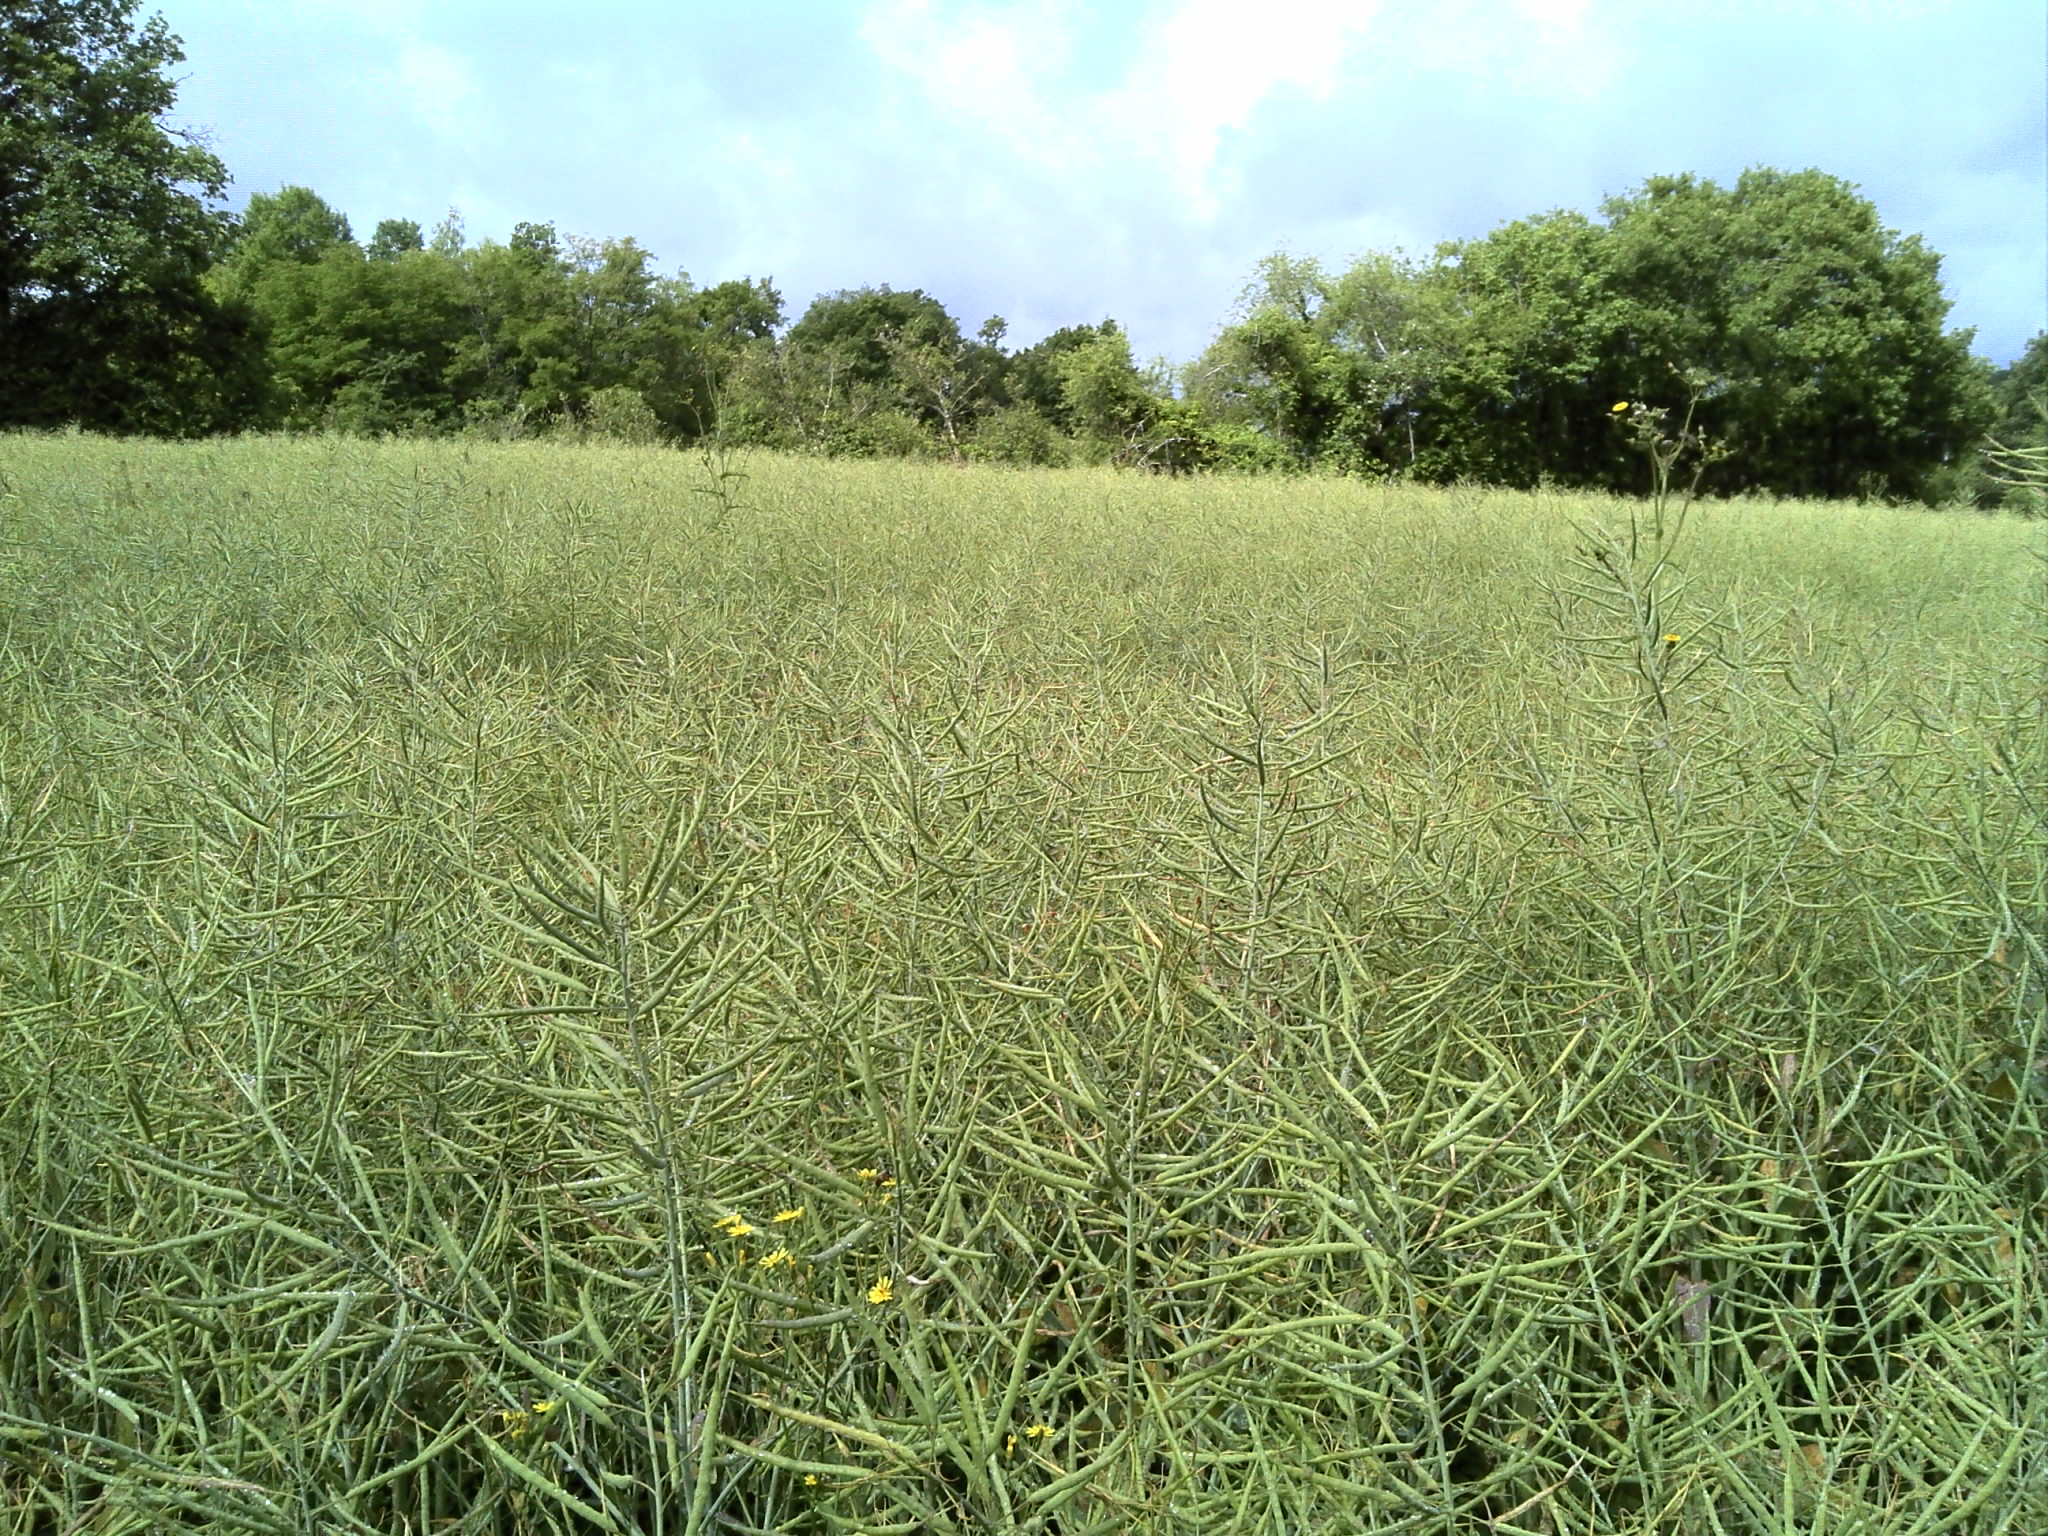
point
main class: Cropland
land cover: Rape and turnip rape
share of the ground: > 75 %
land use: Agriculture (excluding fallow land and kitchen gardens)
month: June
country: FR
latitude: 46.6290
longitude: 1.5126
